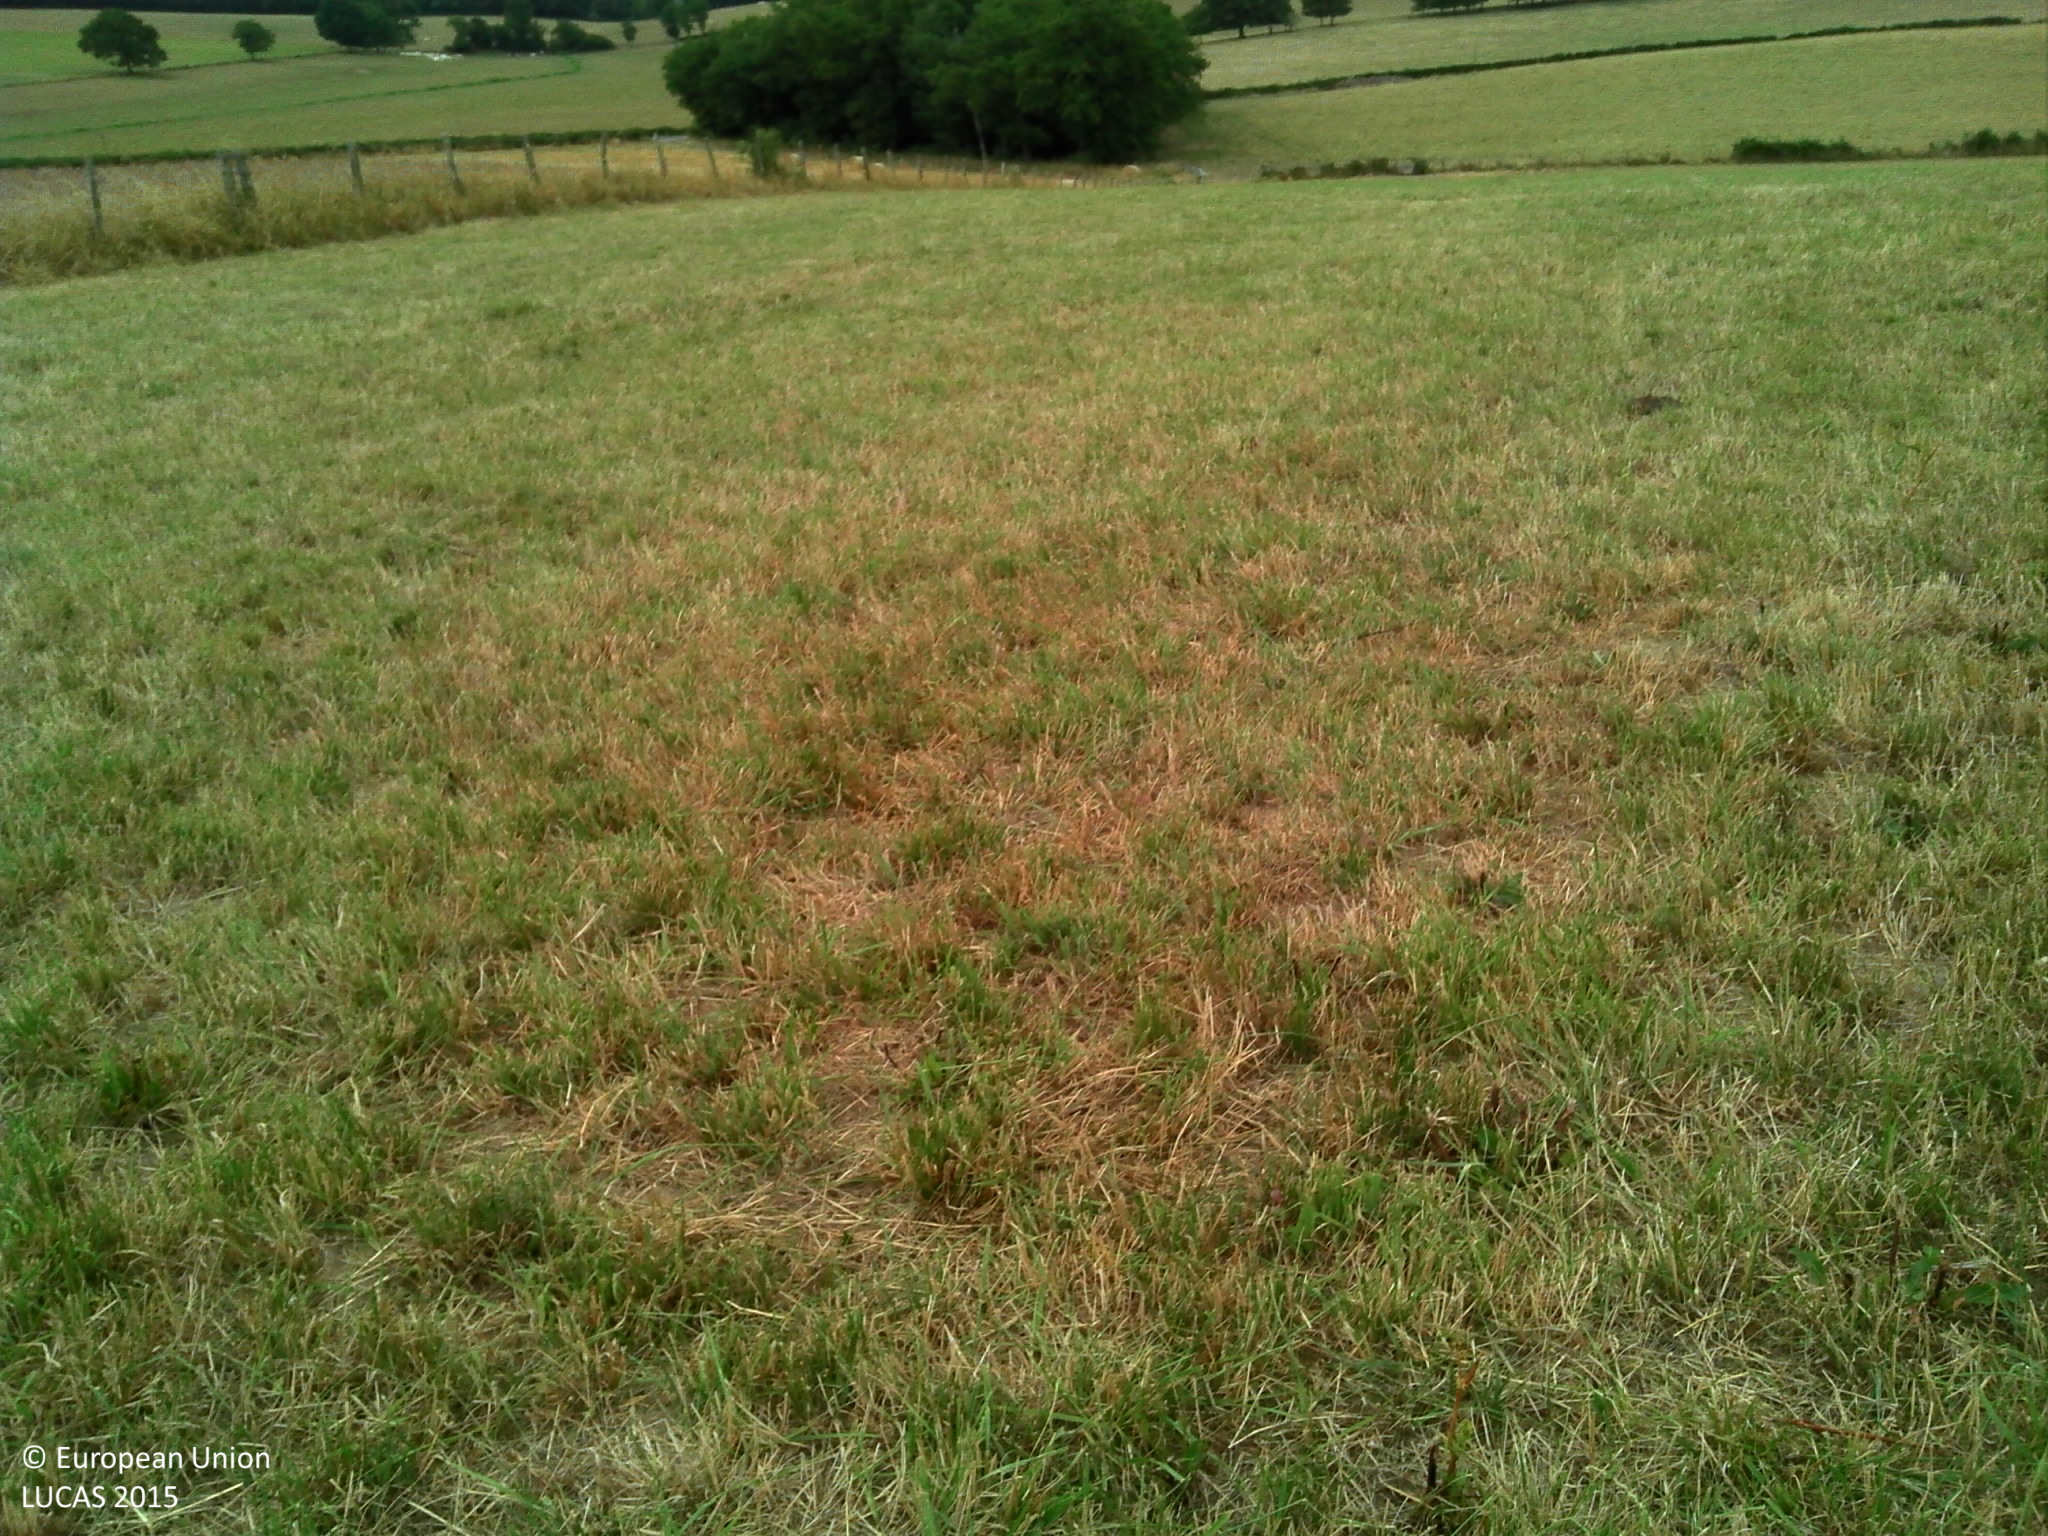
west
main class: Grassland
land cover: Grassland without tree/shrub cover
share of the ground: > 75 %
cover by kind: herbaceous plants 100 %
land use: Agriculture (excluding fallow land and kitchen gardens)
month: July
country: FR
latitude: 46.8389
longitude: 3.1918
